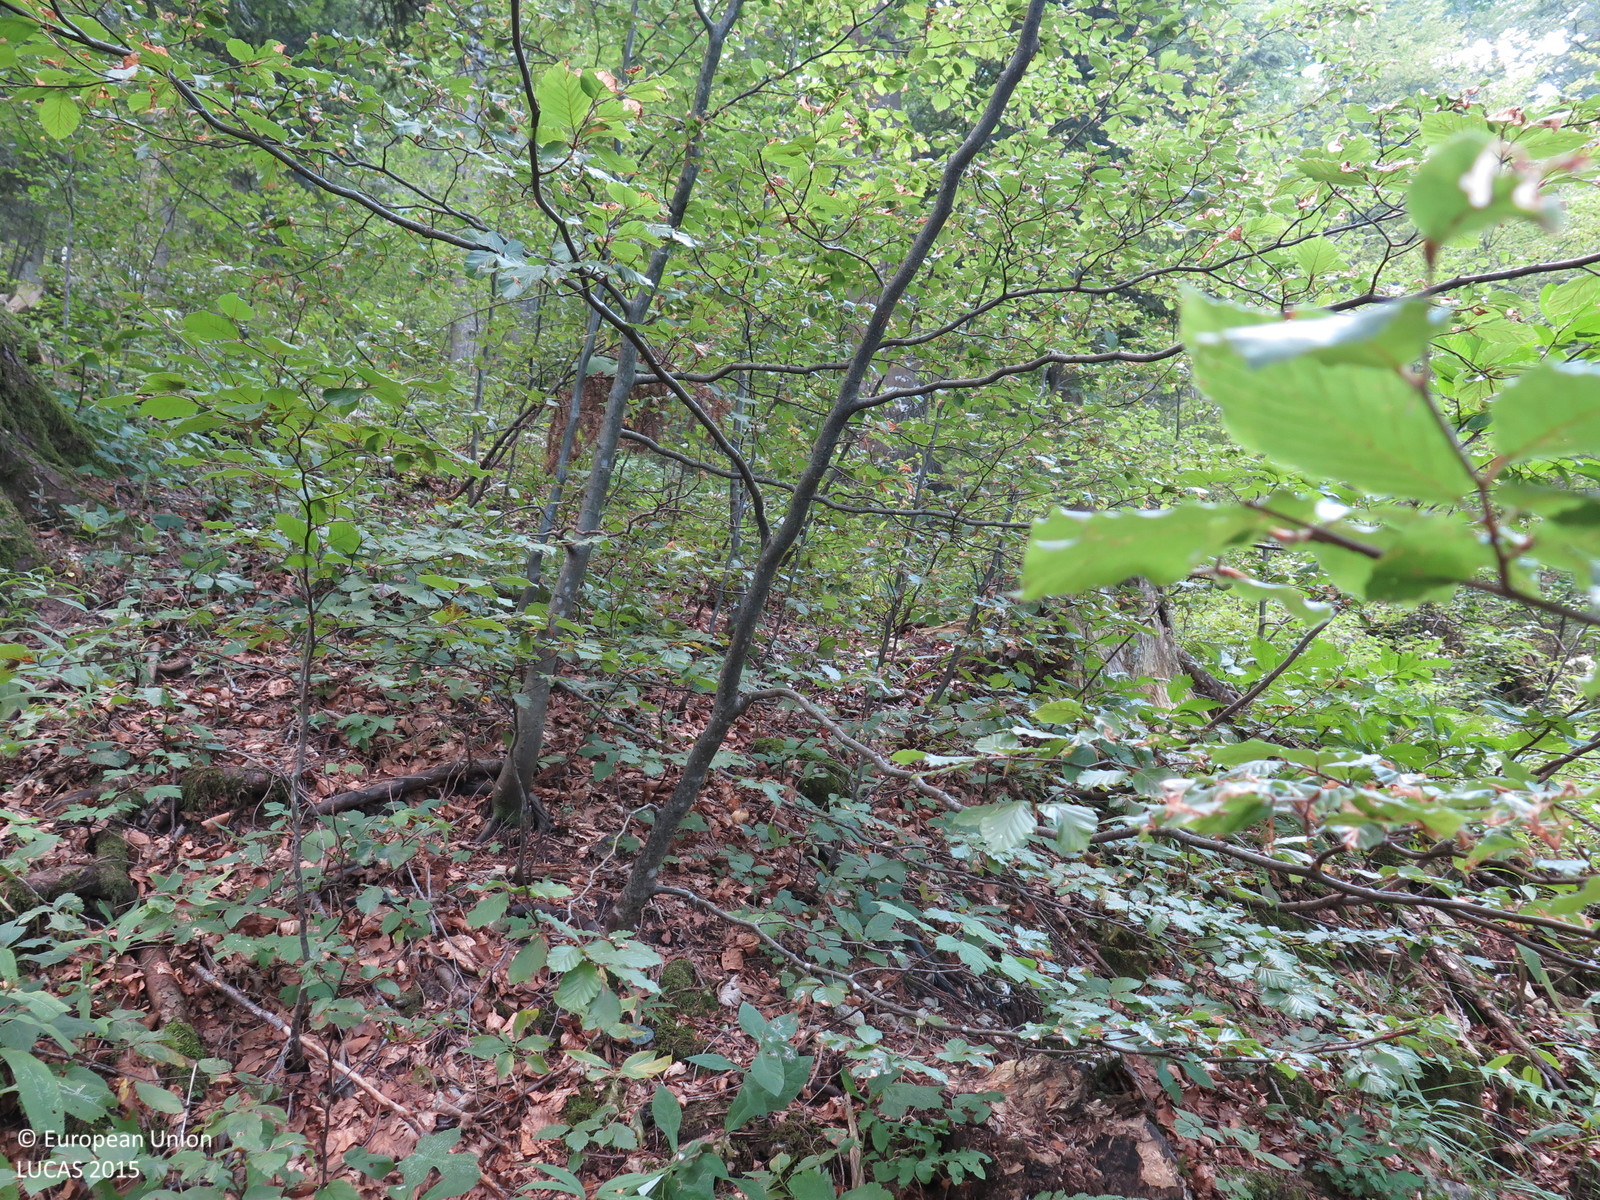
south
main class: Woodland
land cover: Other mixed woodland
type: mountainous beech forest
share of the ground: > 75 %
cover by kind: coniferous forest trees 75 %, broadleaved forest trees 25 %
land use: Forestry
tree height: > 5 m
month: August
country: HR
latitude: 45.3685
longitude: 14.9876
